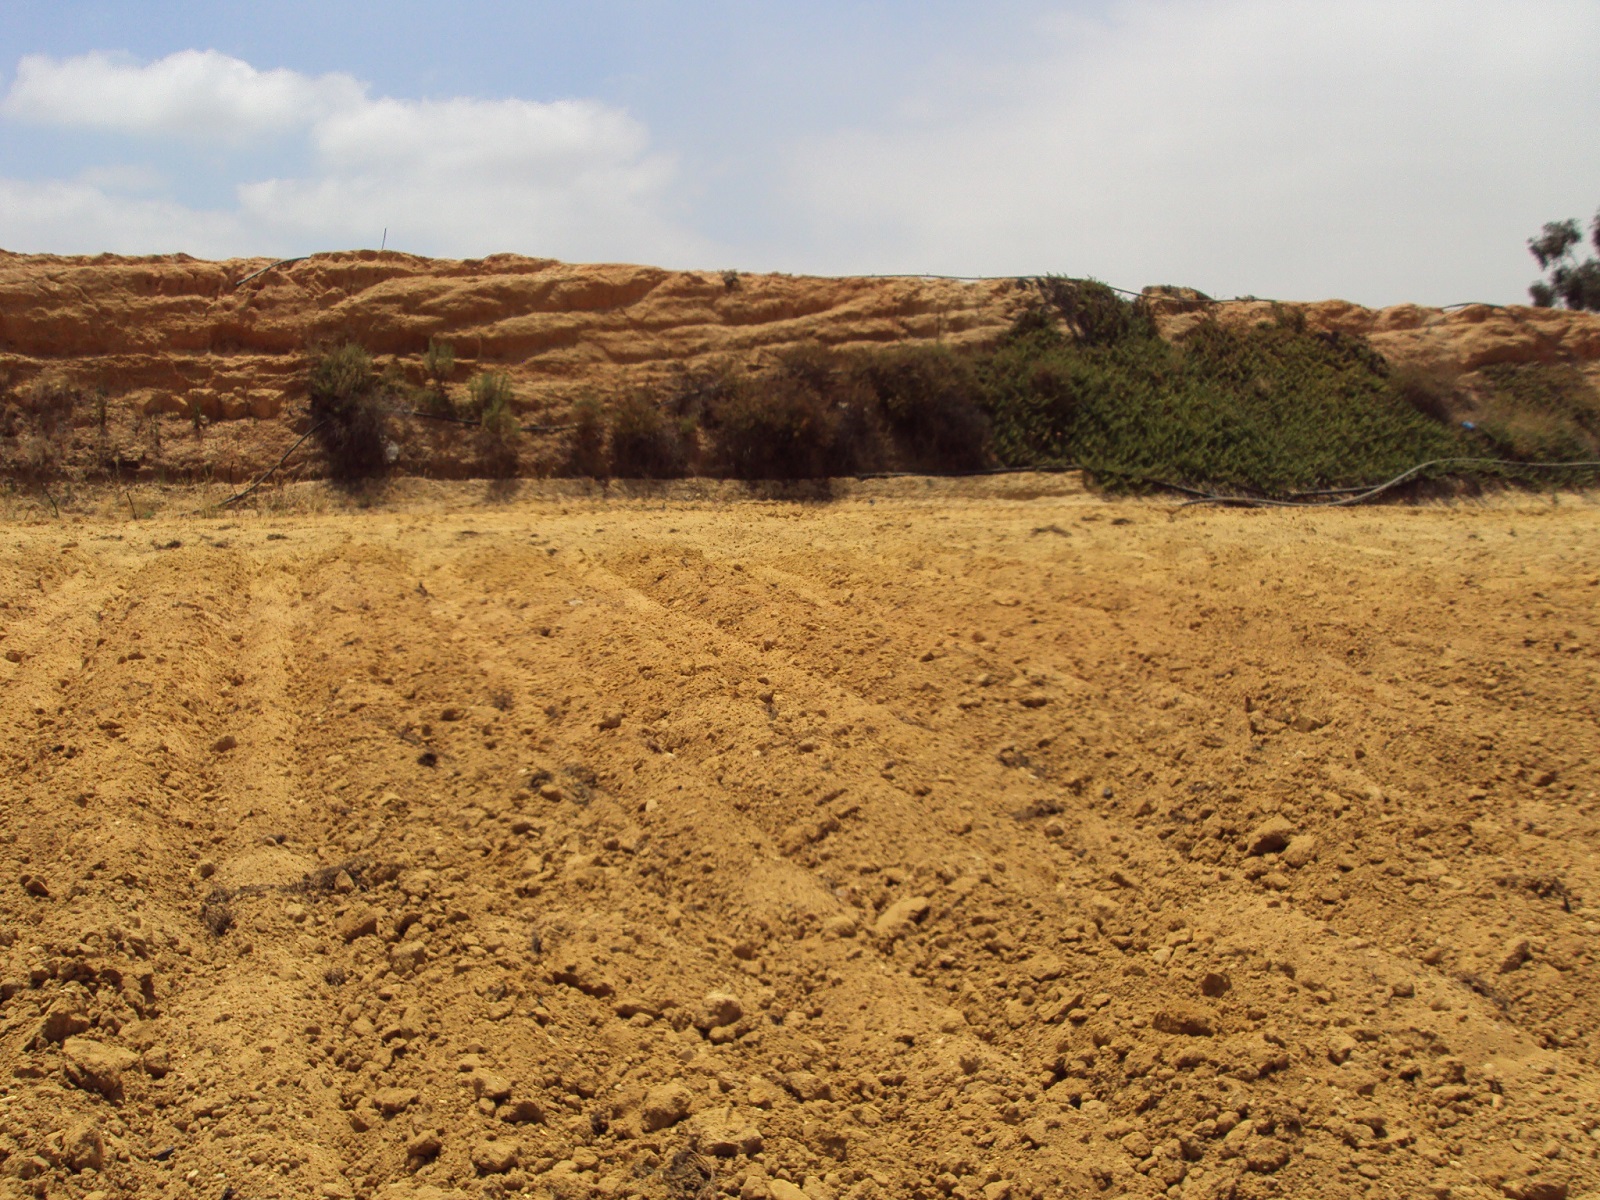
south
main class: Cropland
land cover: Strawberries
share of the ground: > 75 %
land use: Agriculture (excluding fallow land and kitchen gardens)
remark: Harvested field
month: June
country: ES
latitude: 37.2490
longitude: -6.8454
